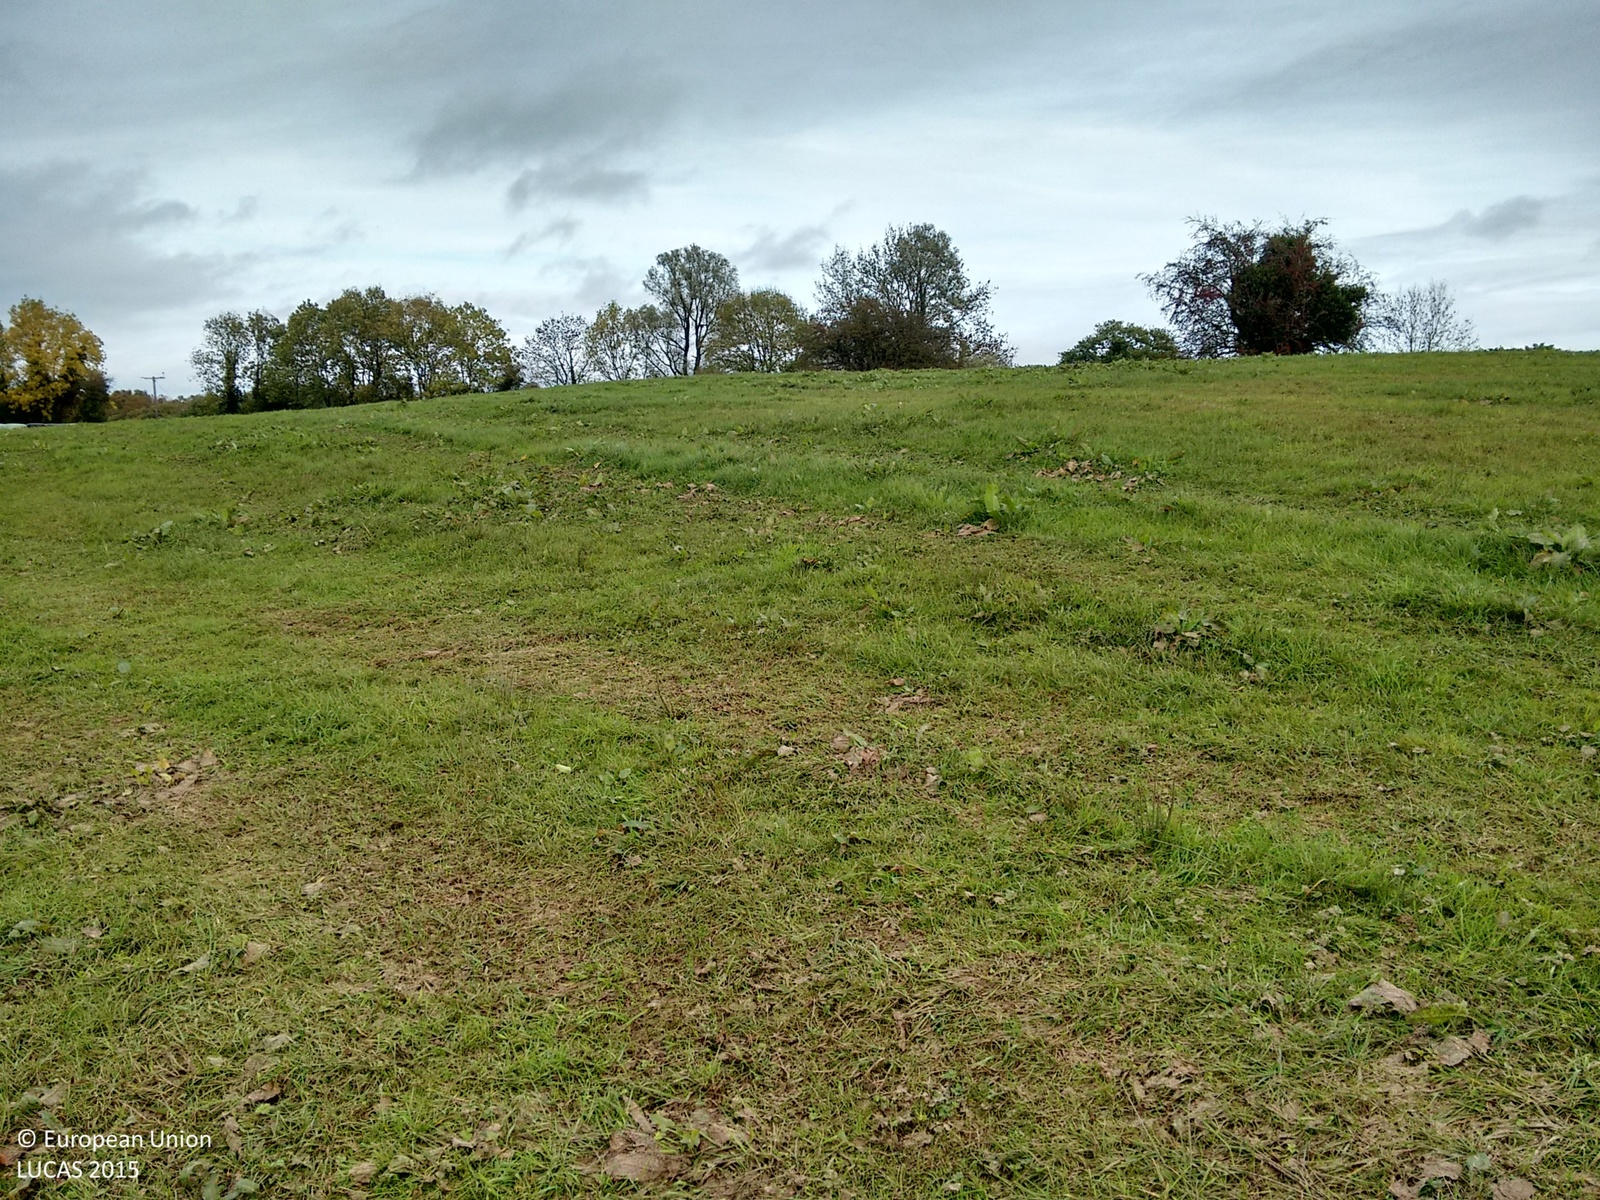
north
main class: Grassland
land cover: Grassland without tree/shrub cover
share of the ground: > 75 %
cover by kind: herbaceous plants 100 %
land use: Agriculture (excluding fallow land and kitchen gardens)
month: October
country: GB
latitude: 54.3008
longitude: -7.4101
